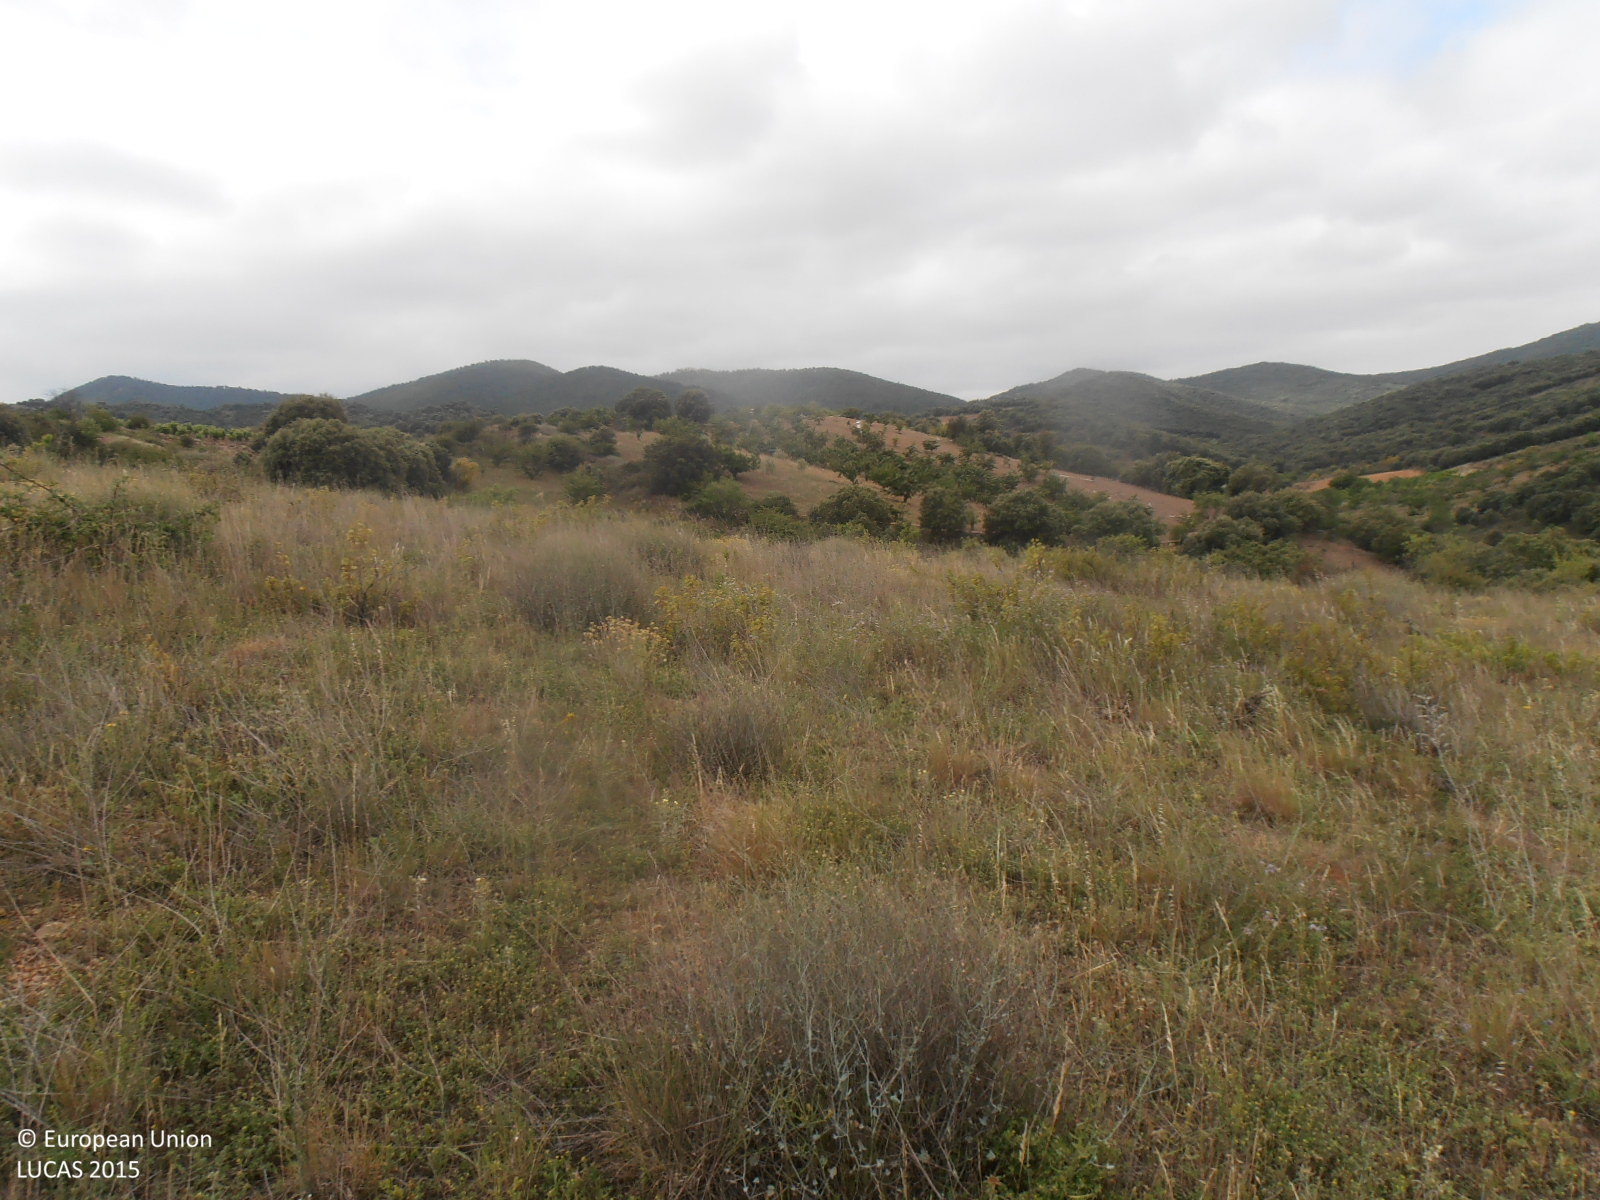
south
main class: Grassland
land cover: Spontaneously vegetated surfaces
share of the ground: > 75 %
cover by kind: herbaceous plants 95 %, shrubs 5 %
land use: Abandoned areas
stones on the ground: > 50 %
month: June
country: ES
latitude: 41.2649
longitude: -1.2051
